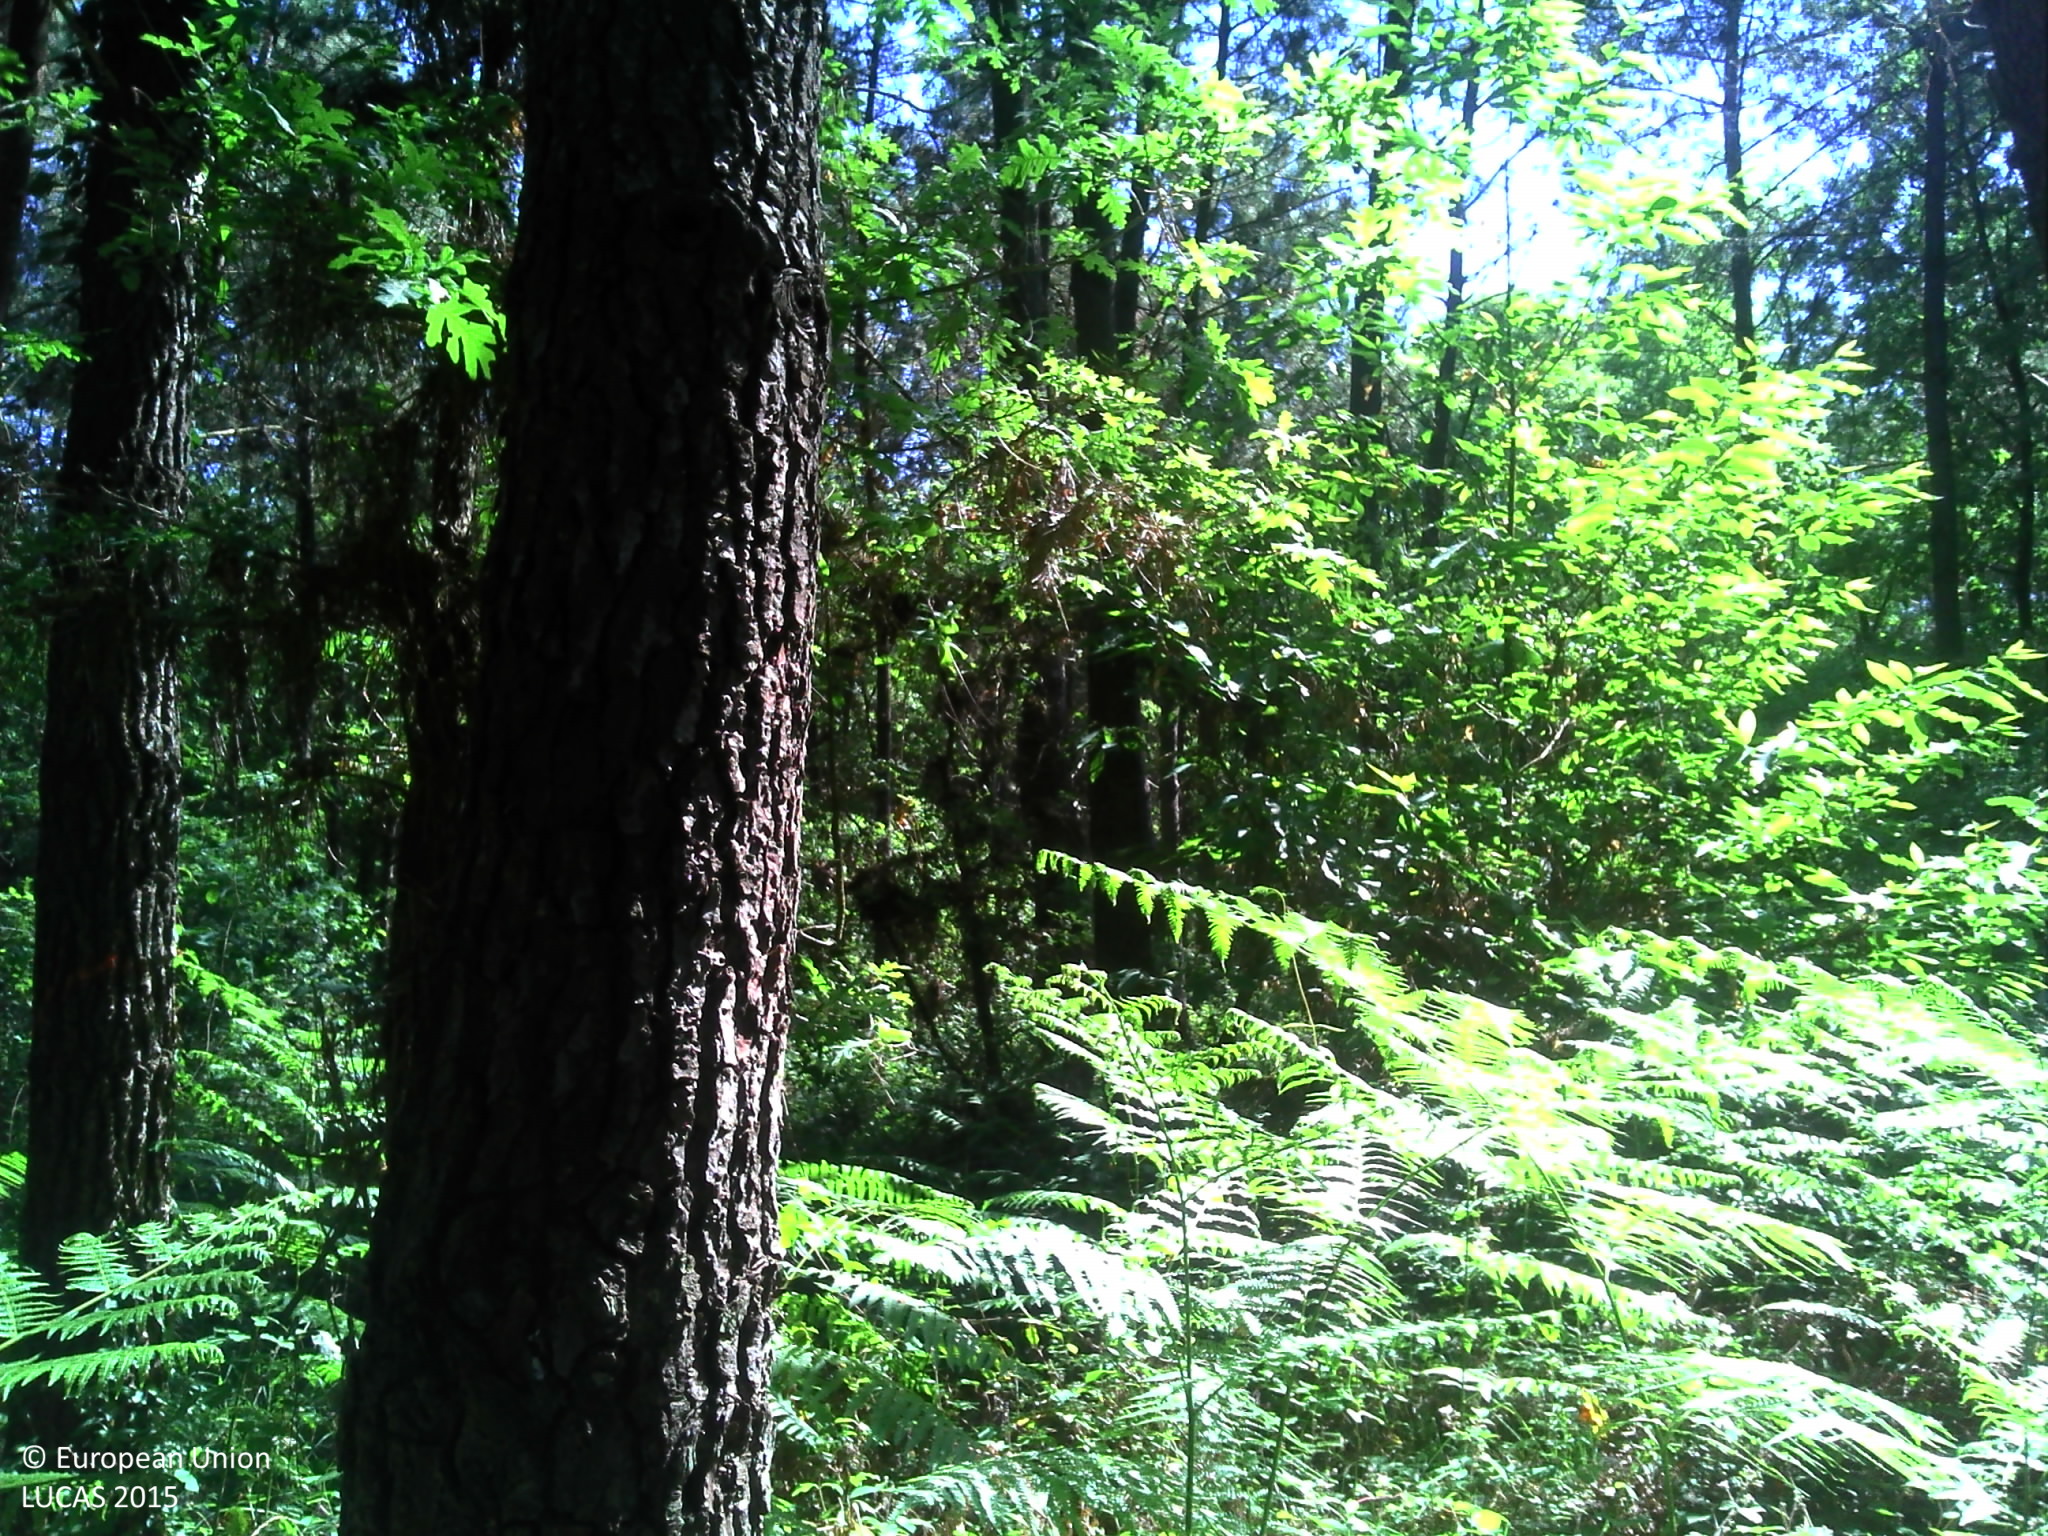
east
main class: Woodland
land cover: Pine dominated mixed woodland
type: hemiboreal forest and nemoral coniferous forest and mixed broadleaved-coniferous forest
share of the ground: > 75 %
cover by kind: coniferous forest trees 40 %, broadleaved forest trees 25 %, shrubs 20 %, herbaceous plants 15 %
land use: Forestry
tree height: > 5 m
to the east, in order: Pine dominated mixed woodland; Grassland without tree/shrub cover; Tracks; Grassland without tree/shrub cover; Pine dominated mixed woodland
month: June
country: FR
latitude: 47.8346
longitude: -0.0613
